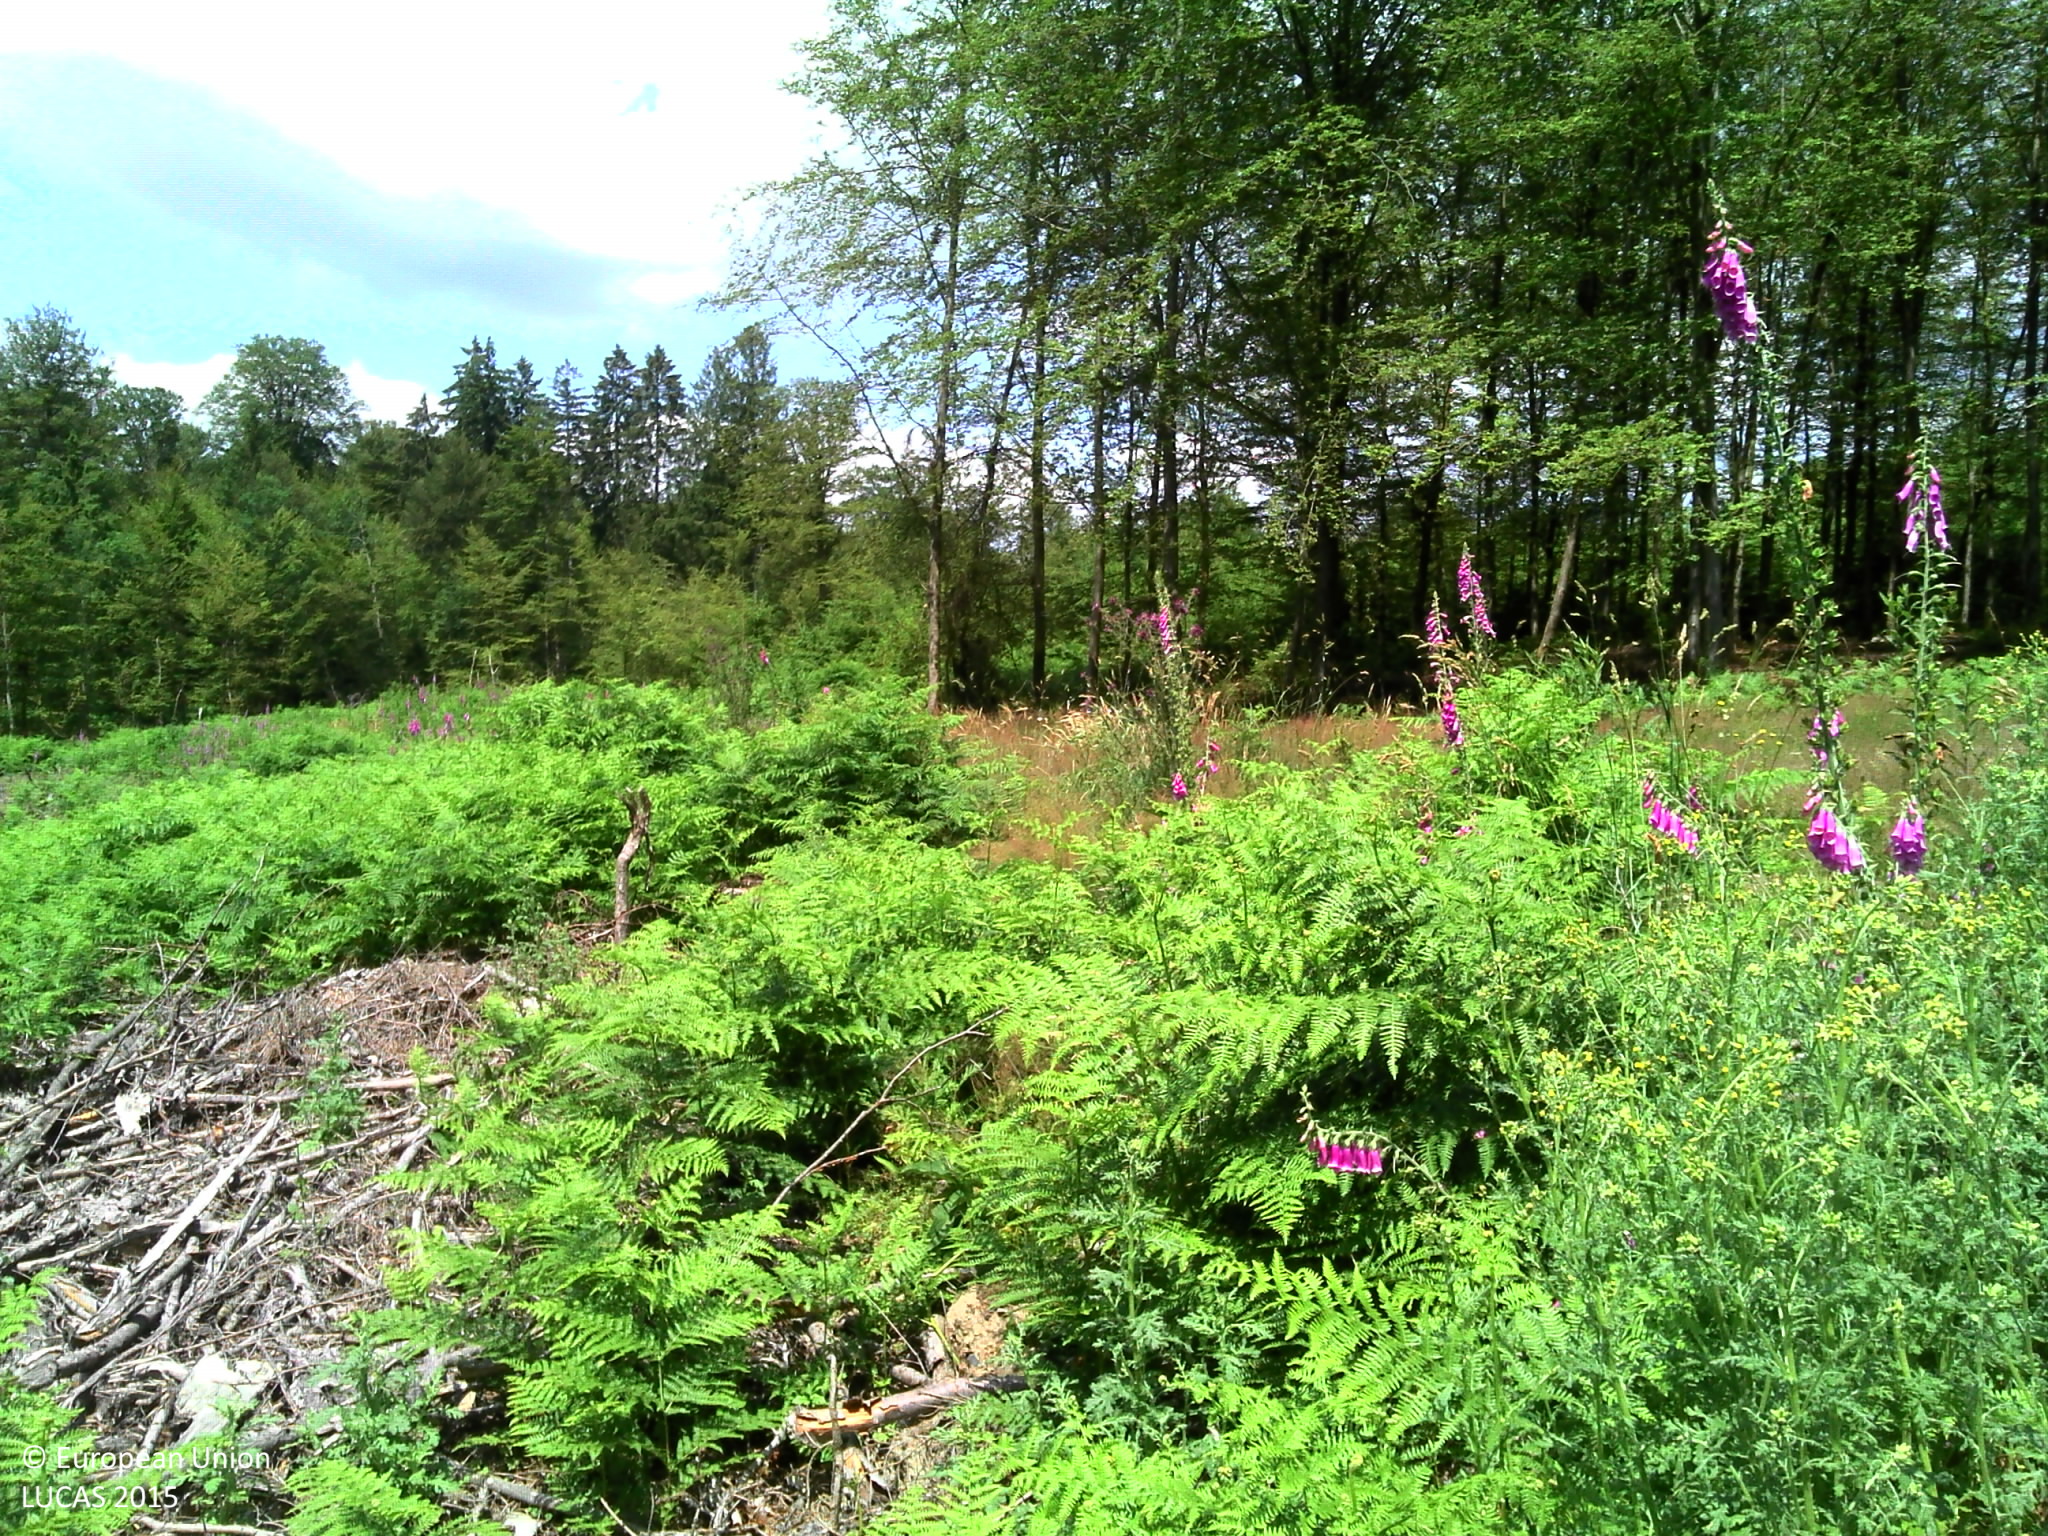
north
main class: Grassland
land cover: Spontaneously vegetated surfaces
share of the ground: > 75 %
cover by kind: herbaceous plants 60 %, unconsolidated bare surface 40 %
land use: Forestry
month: July
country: BE
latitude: 49.8704
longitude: 5.2812
